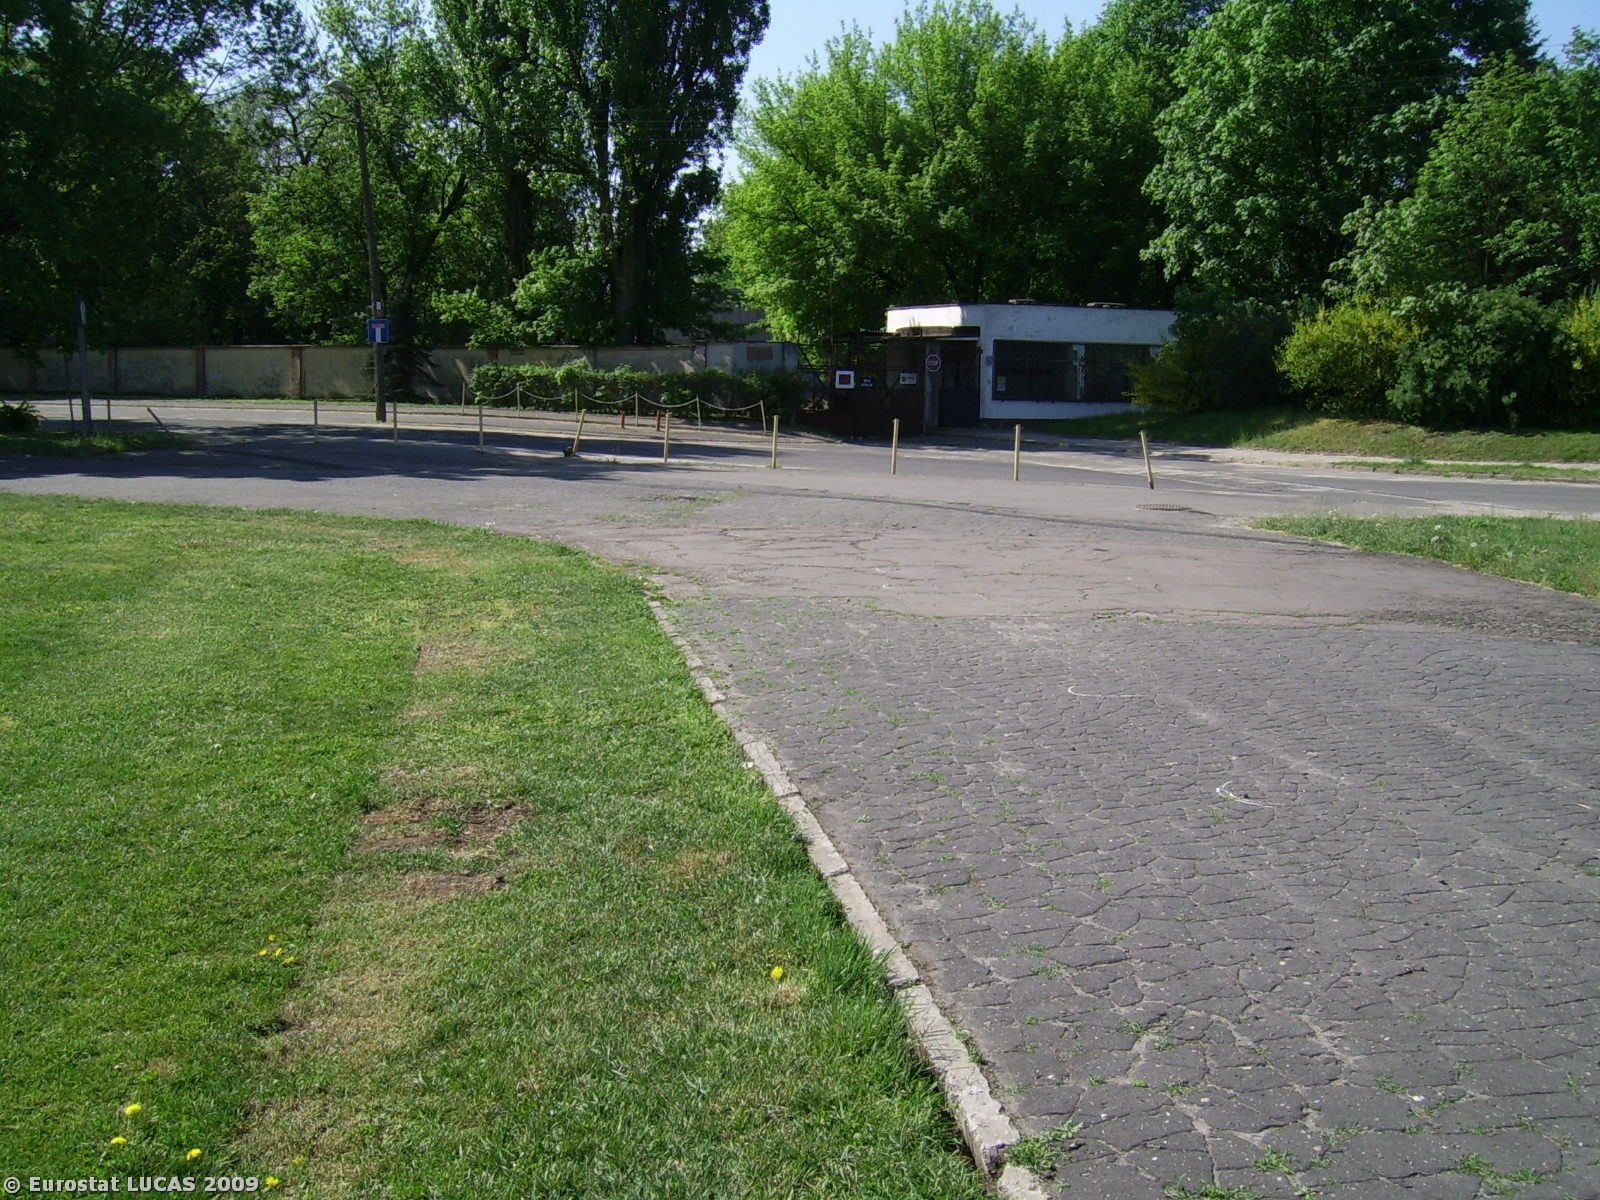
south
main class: Grassland
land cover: Grassland without tree/shrub cover
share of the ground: > 75 %
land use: Amenities, museums, leisure
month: May
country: PL
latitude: 52.4076
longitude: 16.9627
